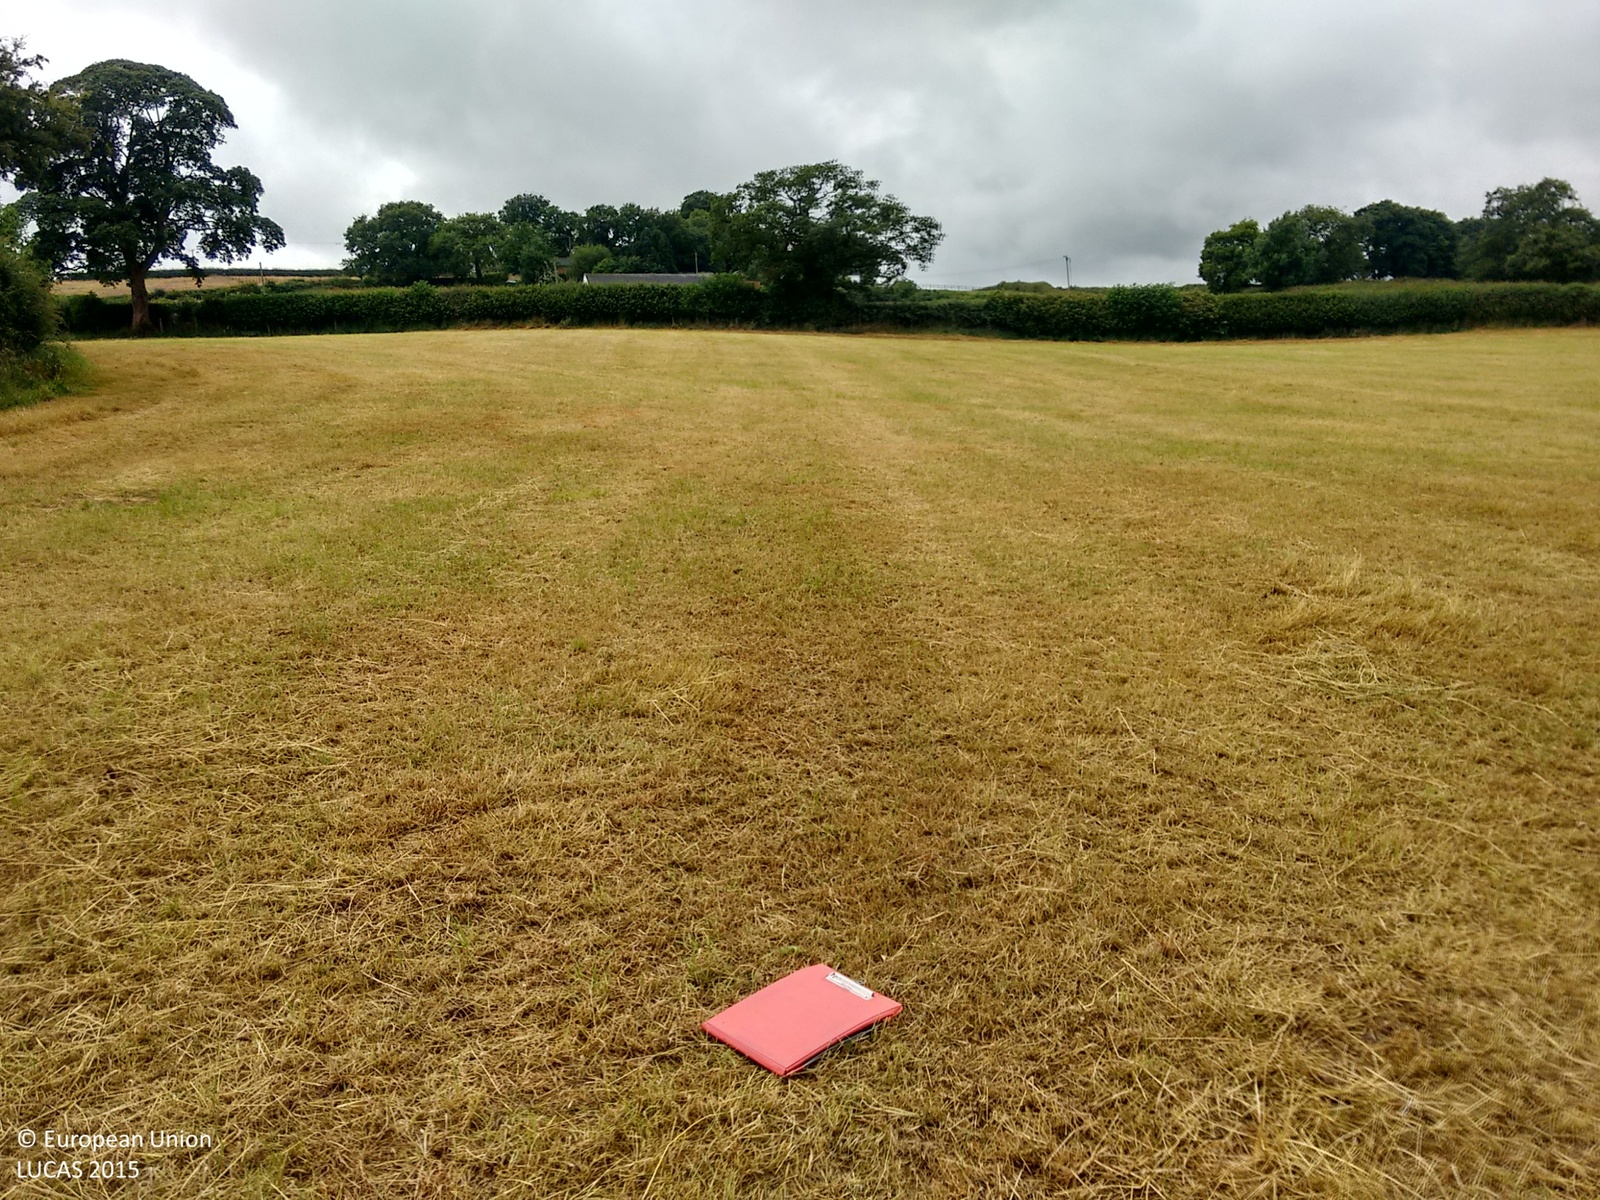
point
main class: Grassland
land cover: Grassland without tree/shrub cover
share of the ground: > 75 %
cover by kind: herbaceous plants 100 %
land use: Agriculture (excluding fallow land and kitchen gardens)
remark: Harvested field
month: July
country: GB
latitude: 52.9288
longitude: -2.3664
